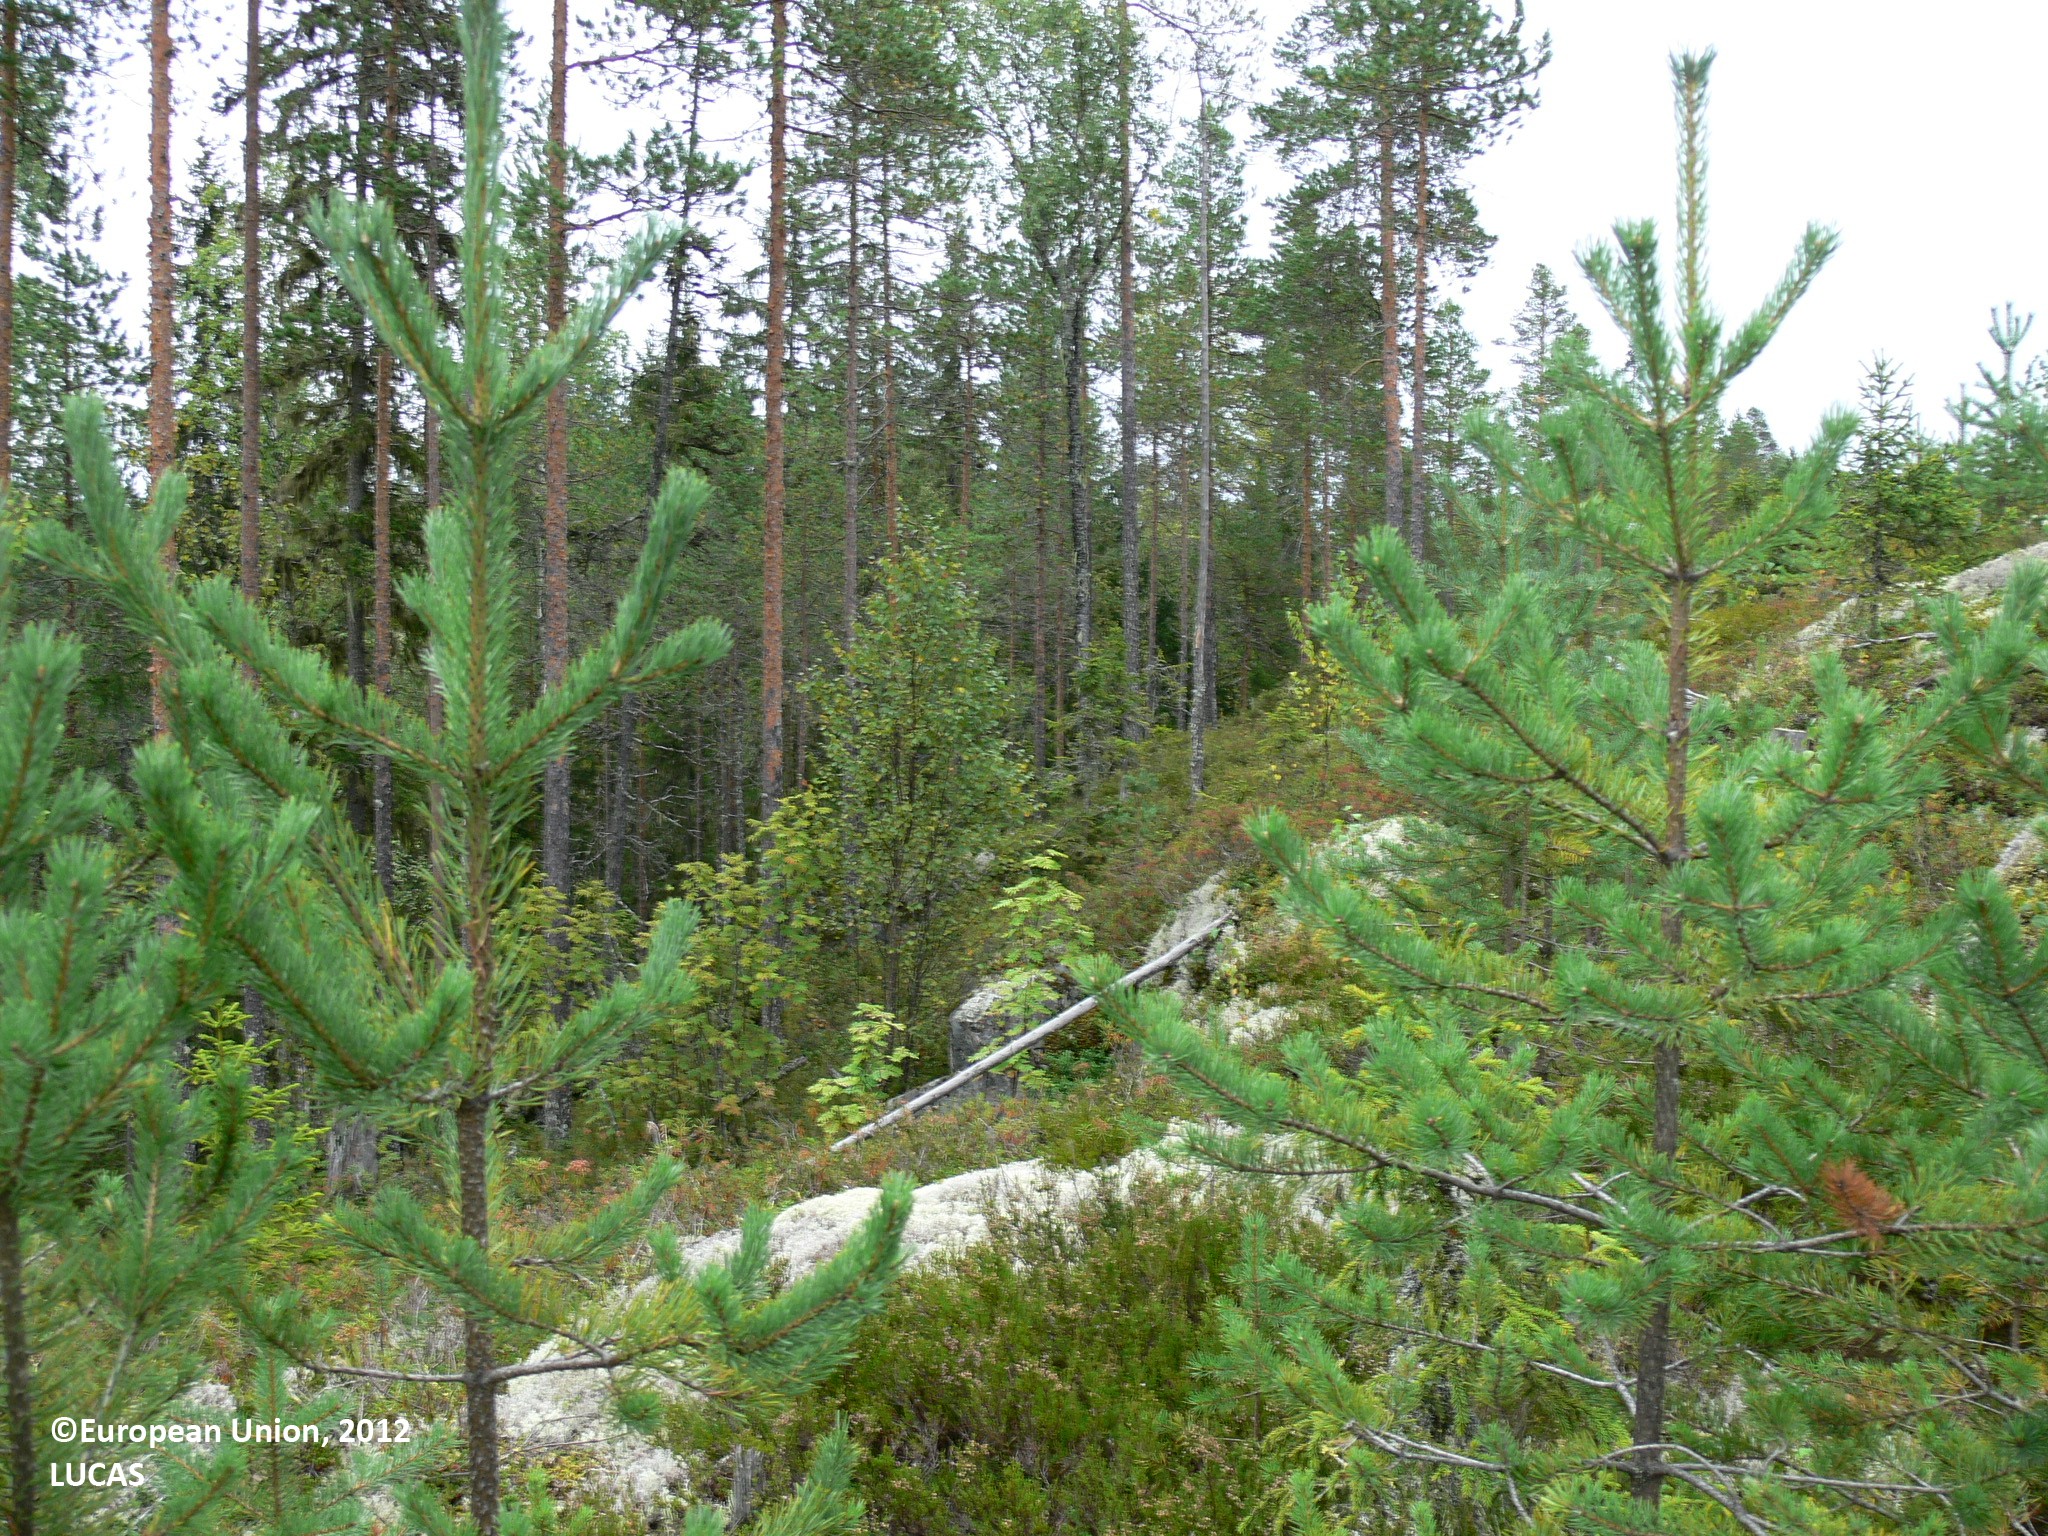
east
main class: Woodland
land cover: Pine dominated mixed woodland
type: boreal forest
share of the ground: 25 - 50 %
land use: Forestry
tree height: < 5 m
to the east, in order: Pine dominated mixed woodland; Pine dominated coniferous woodland; Other mixed woodland; Inland running water; Pine dominated mixed woodland; Pine dominated coniferous woodland; Pine dominated mixed woodland; Pine dominated coniferous woodland
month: August
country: FI
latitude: 63.1712
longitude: 30.1795
